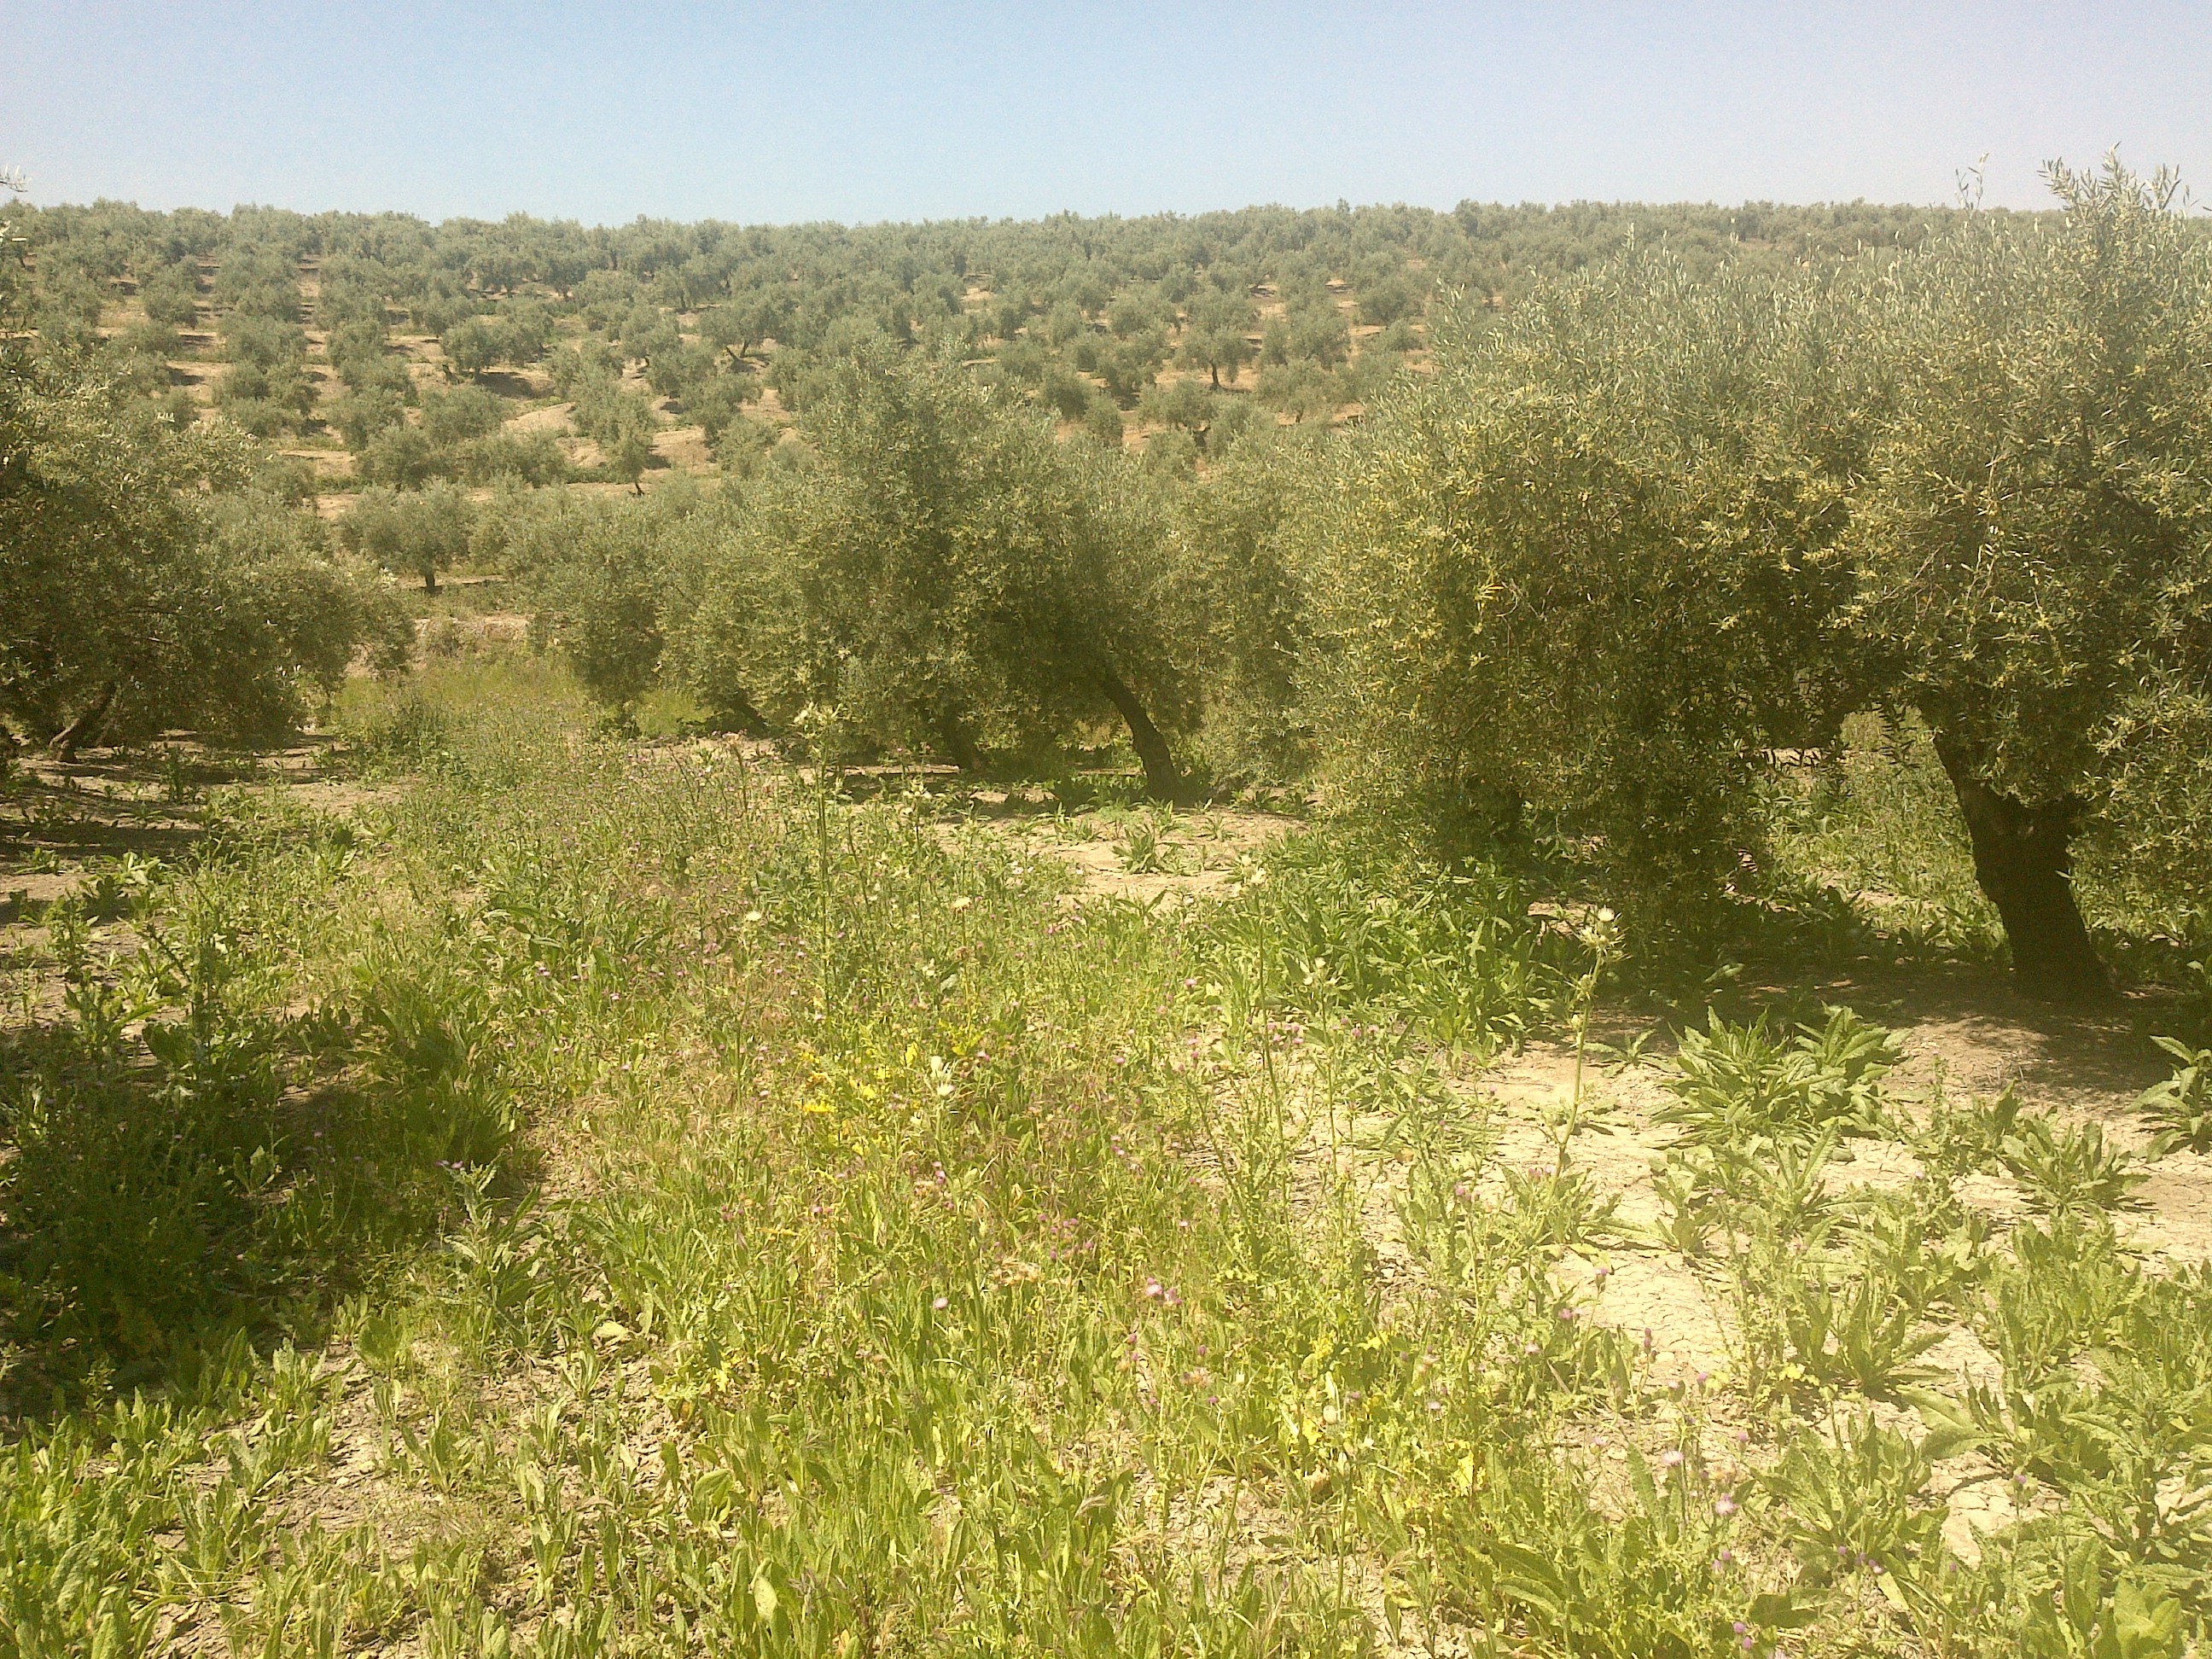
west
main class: Cropland
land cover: Olive groves
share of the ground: 50 - 75 %
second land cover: Spontaneously vegetated surfaces
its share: 50 - 75 %
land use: Agriculture (excluding fallow land and kitchen gardens)
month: May
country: ES
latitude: 37.6805
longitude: -4.6018
